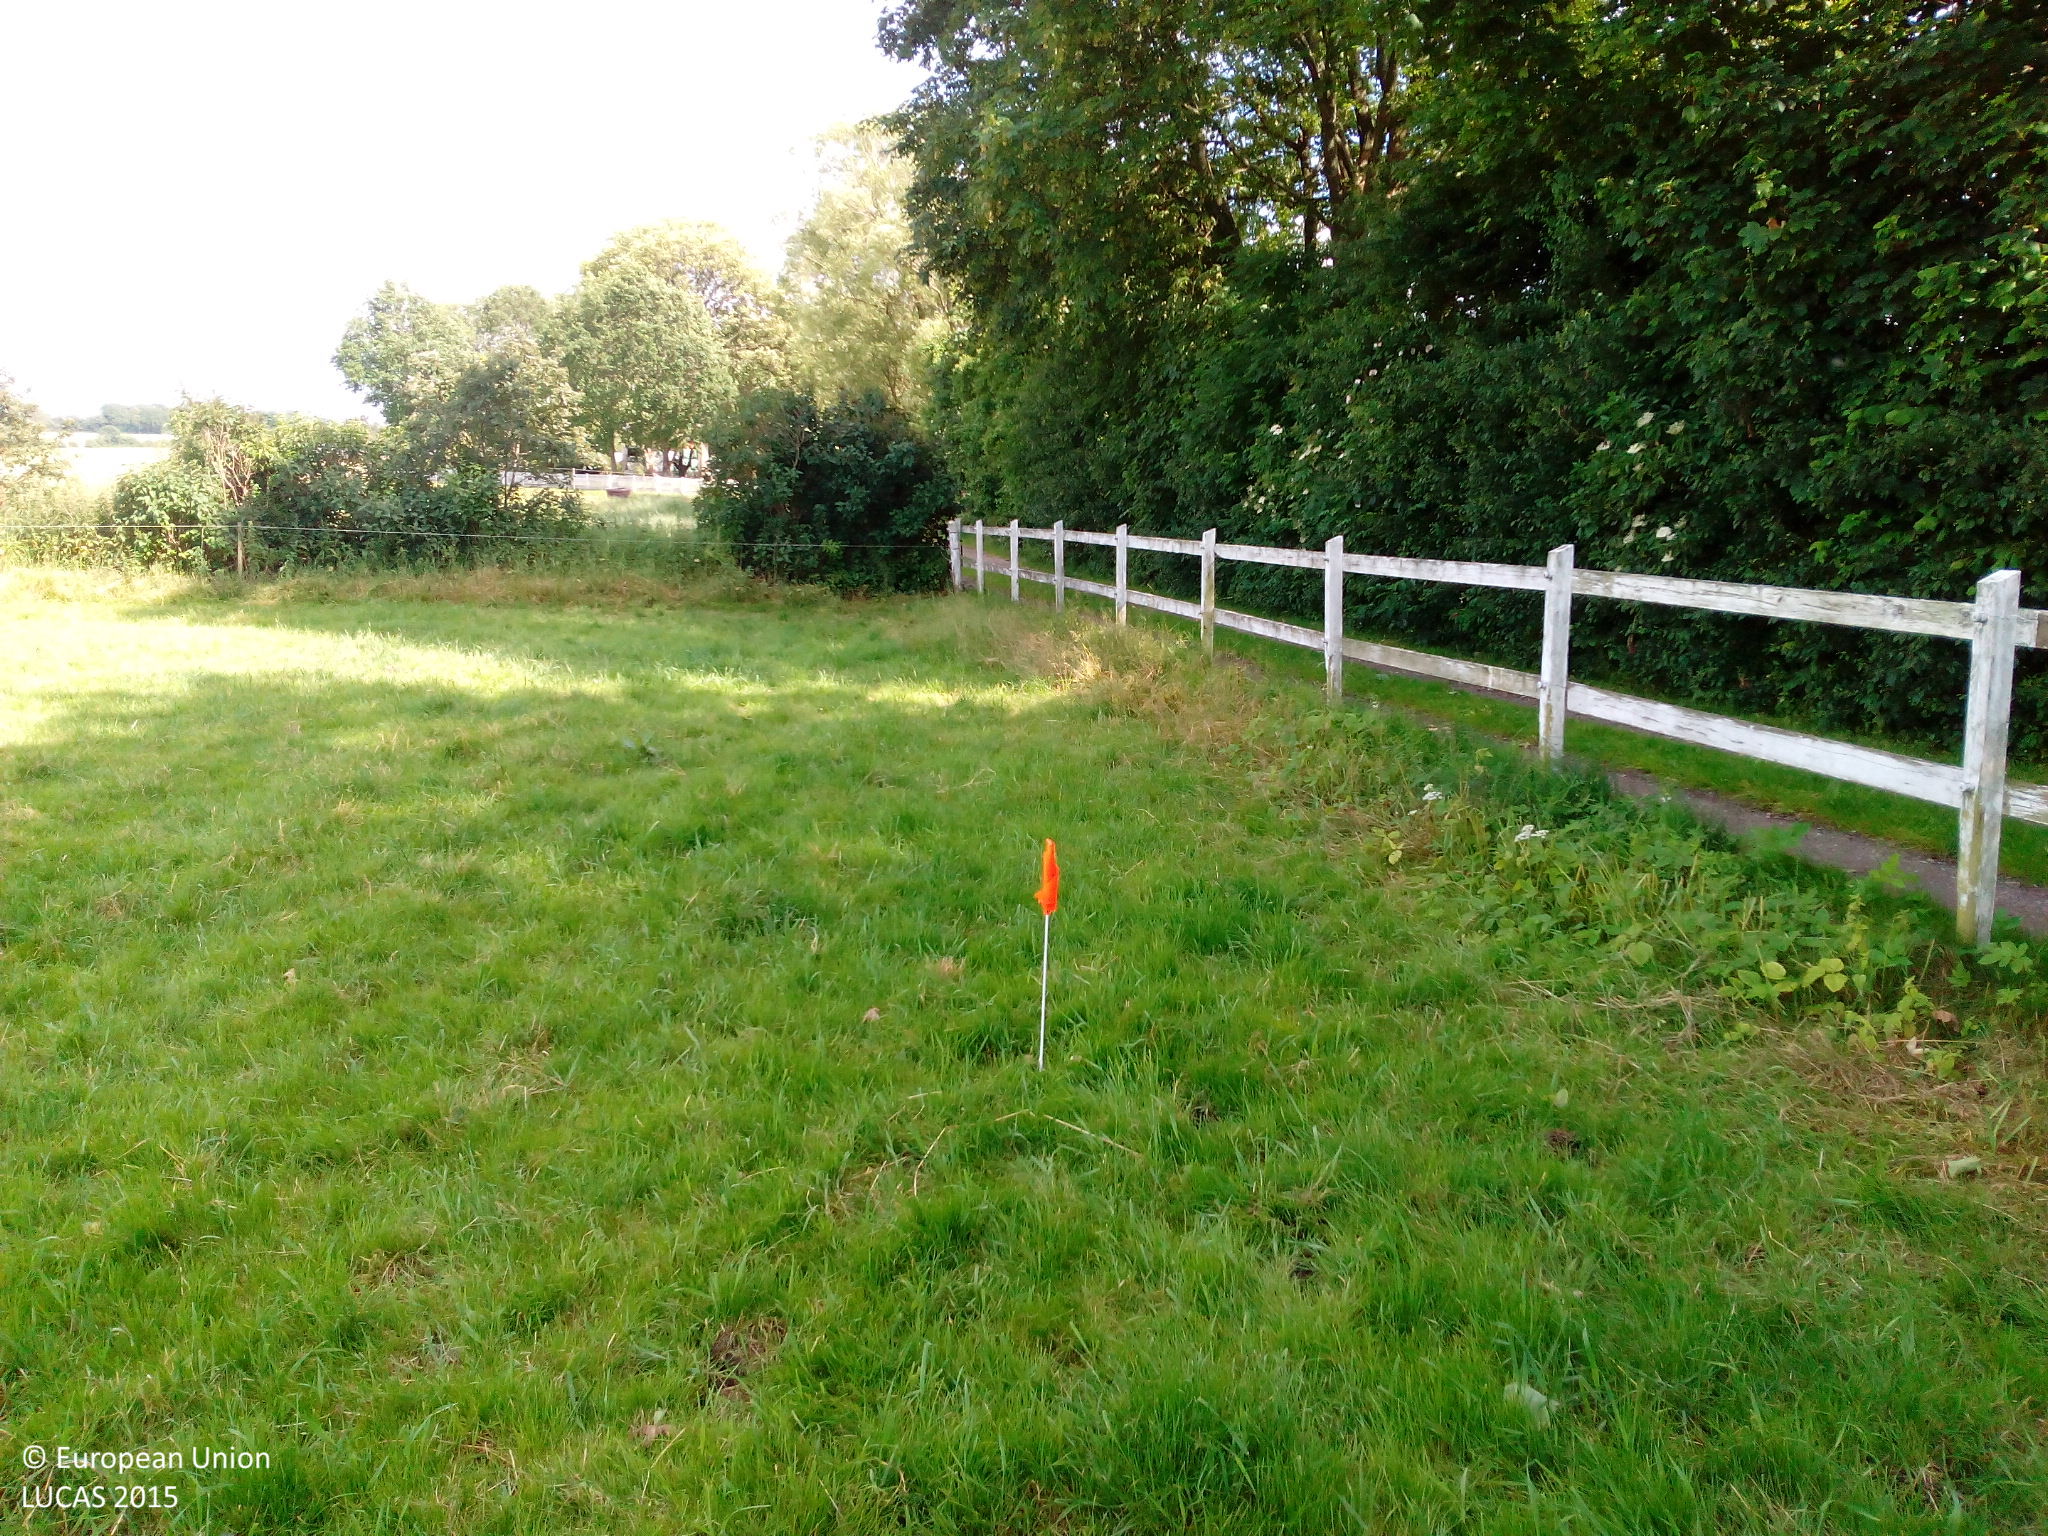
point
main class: Grassland
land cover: Grassland without tree/shrub cover
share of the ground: > 75 %
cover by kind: herbaceous plants 100 %
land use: Agriculture (excluding fallow land and kitchen gardens)
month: July
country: DK
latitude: 55.2907
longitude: 12.0299
